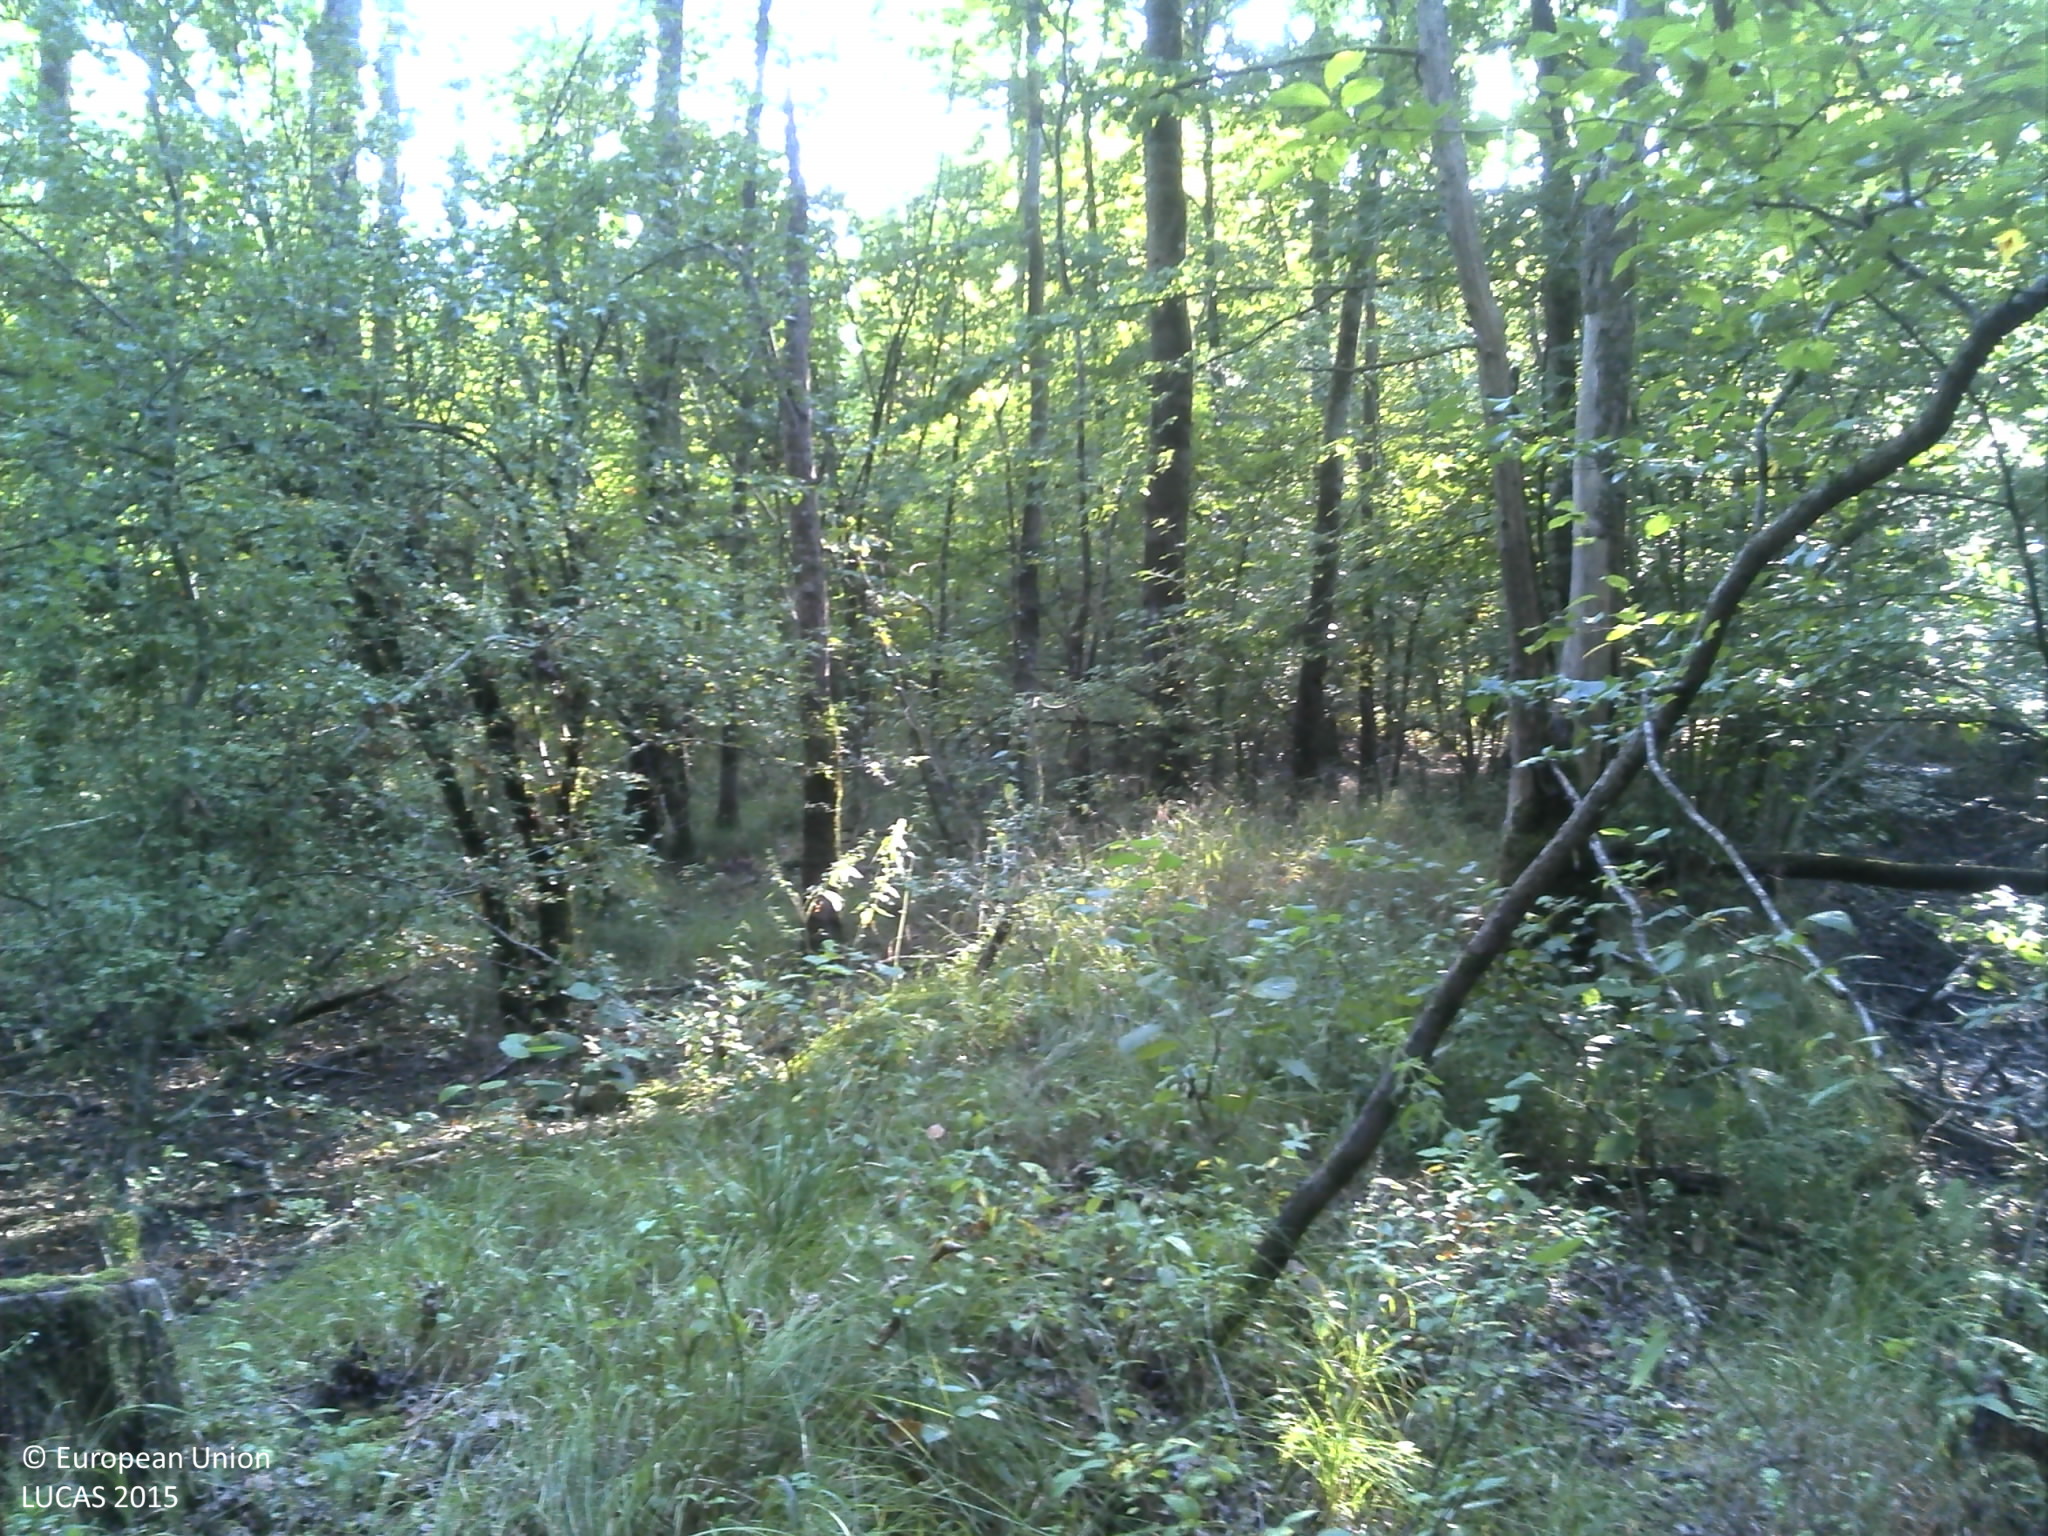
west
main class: Woodland
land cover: Broadleaved woodland
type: mesophytic deciduous forest
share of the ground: > 75 %
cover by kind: broadleaved forest trees 100 %
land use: Forestry
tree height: > 5 m
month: September
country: HR
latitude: 45.5175
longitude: 15.6163
